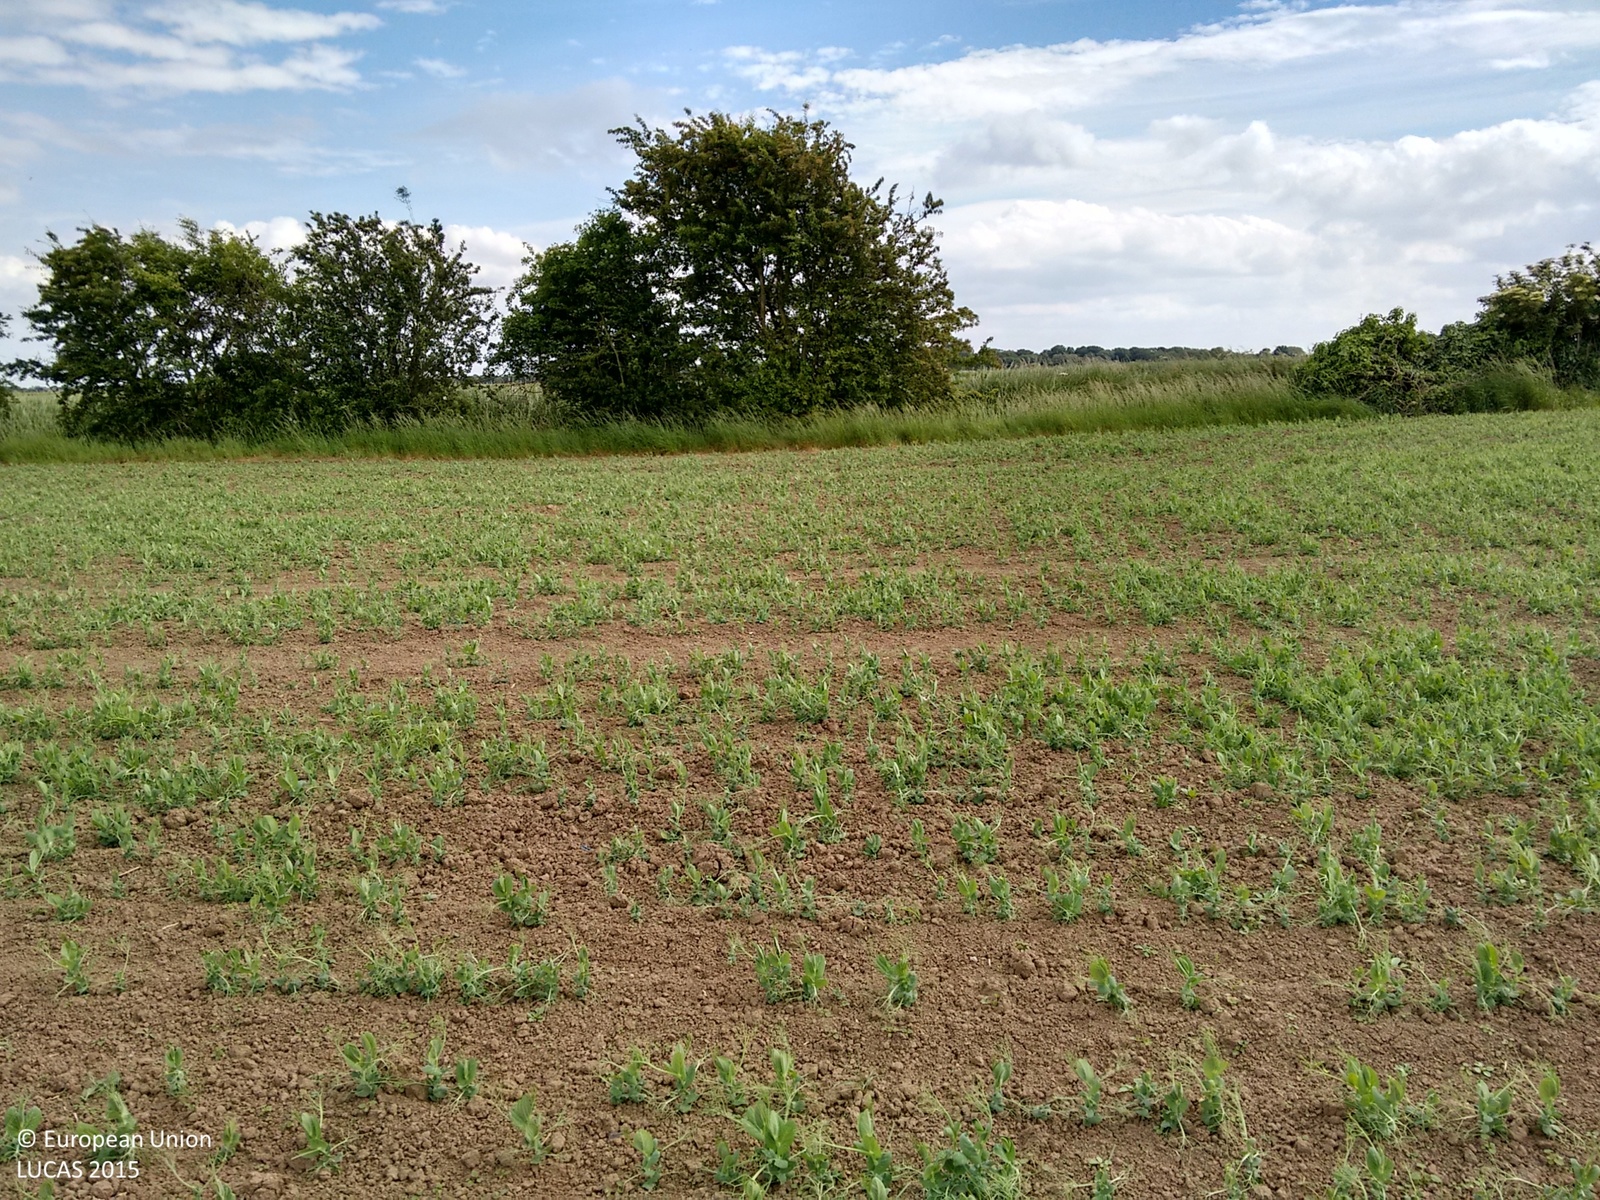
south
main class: Cropland
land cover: Dry pulses
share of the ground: 25 - 50 %
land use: Agriculture (excluding fallow land and kitchen gardens)
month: June
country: GB
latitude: 53.0178
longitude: -0.0651
